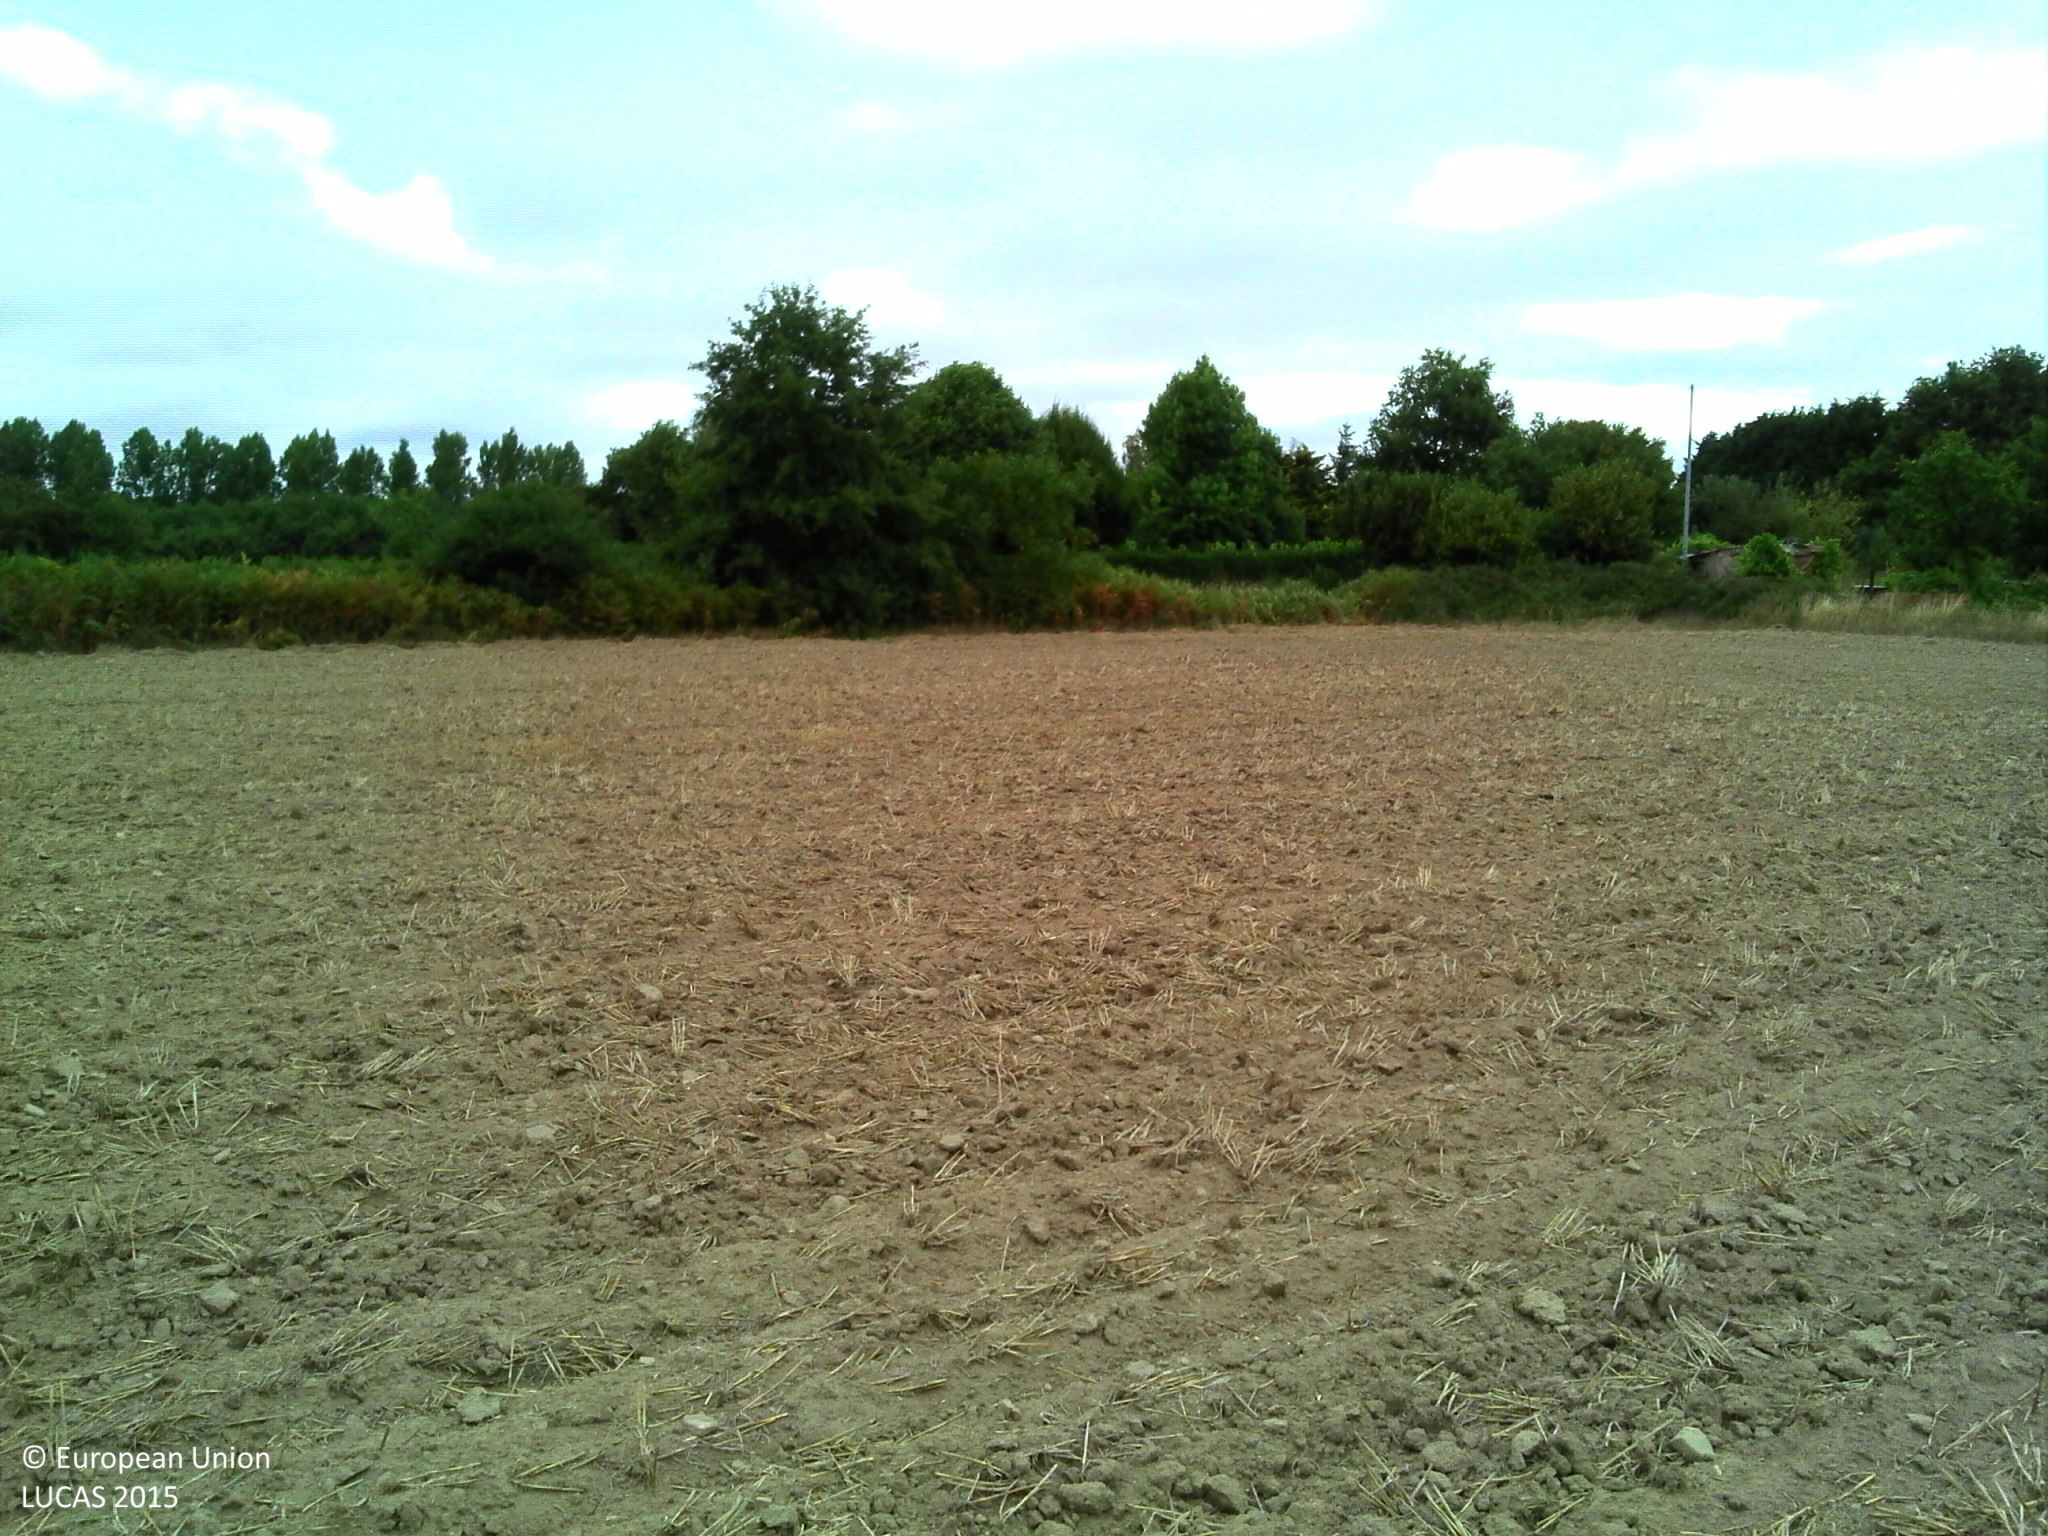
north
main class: Cropland
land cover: Common wheat
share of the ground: < 10 %
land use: Agriculture (excluding fallow land and kitchen gardens)
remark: Tilled/Sowed
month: August
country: FR
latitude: 47.7277
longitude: -1.3346
